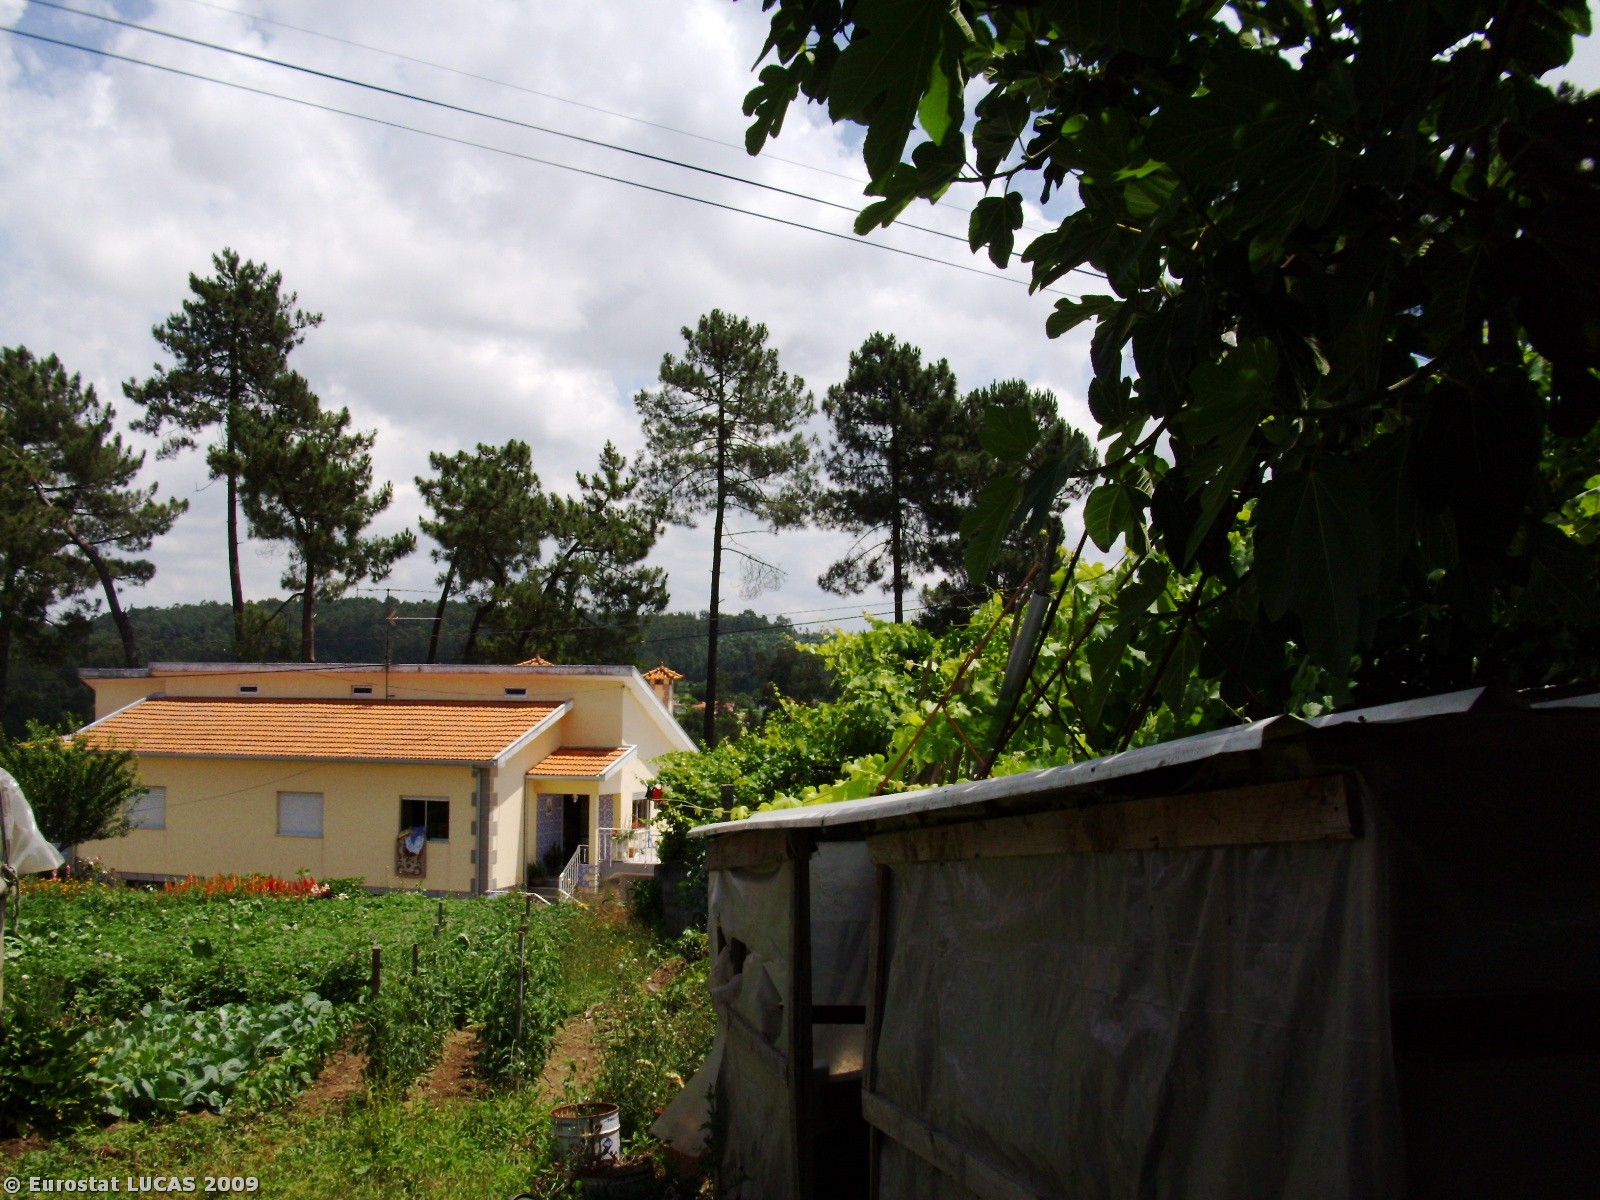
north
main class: Artificial land
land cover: Greenhouses
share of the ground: 25 - 50 %
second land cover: Nurseries
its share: 25 - 50 %
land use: Kitchen garden
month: June
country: PT
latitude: 41.4923
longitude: -8.5674
